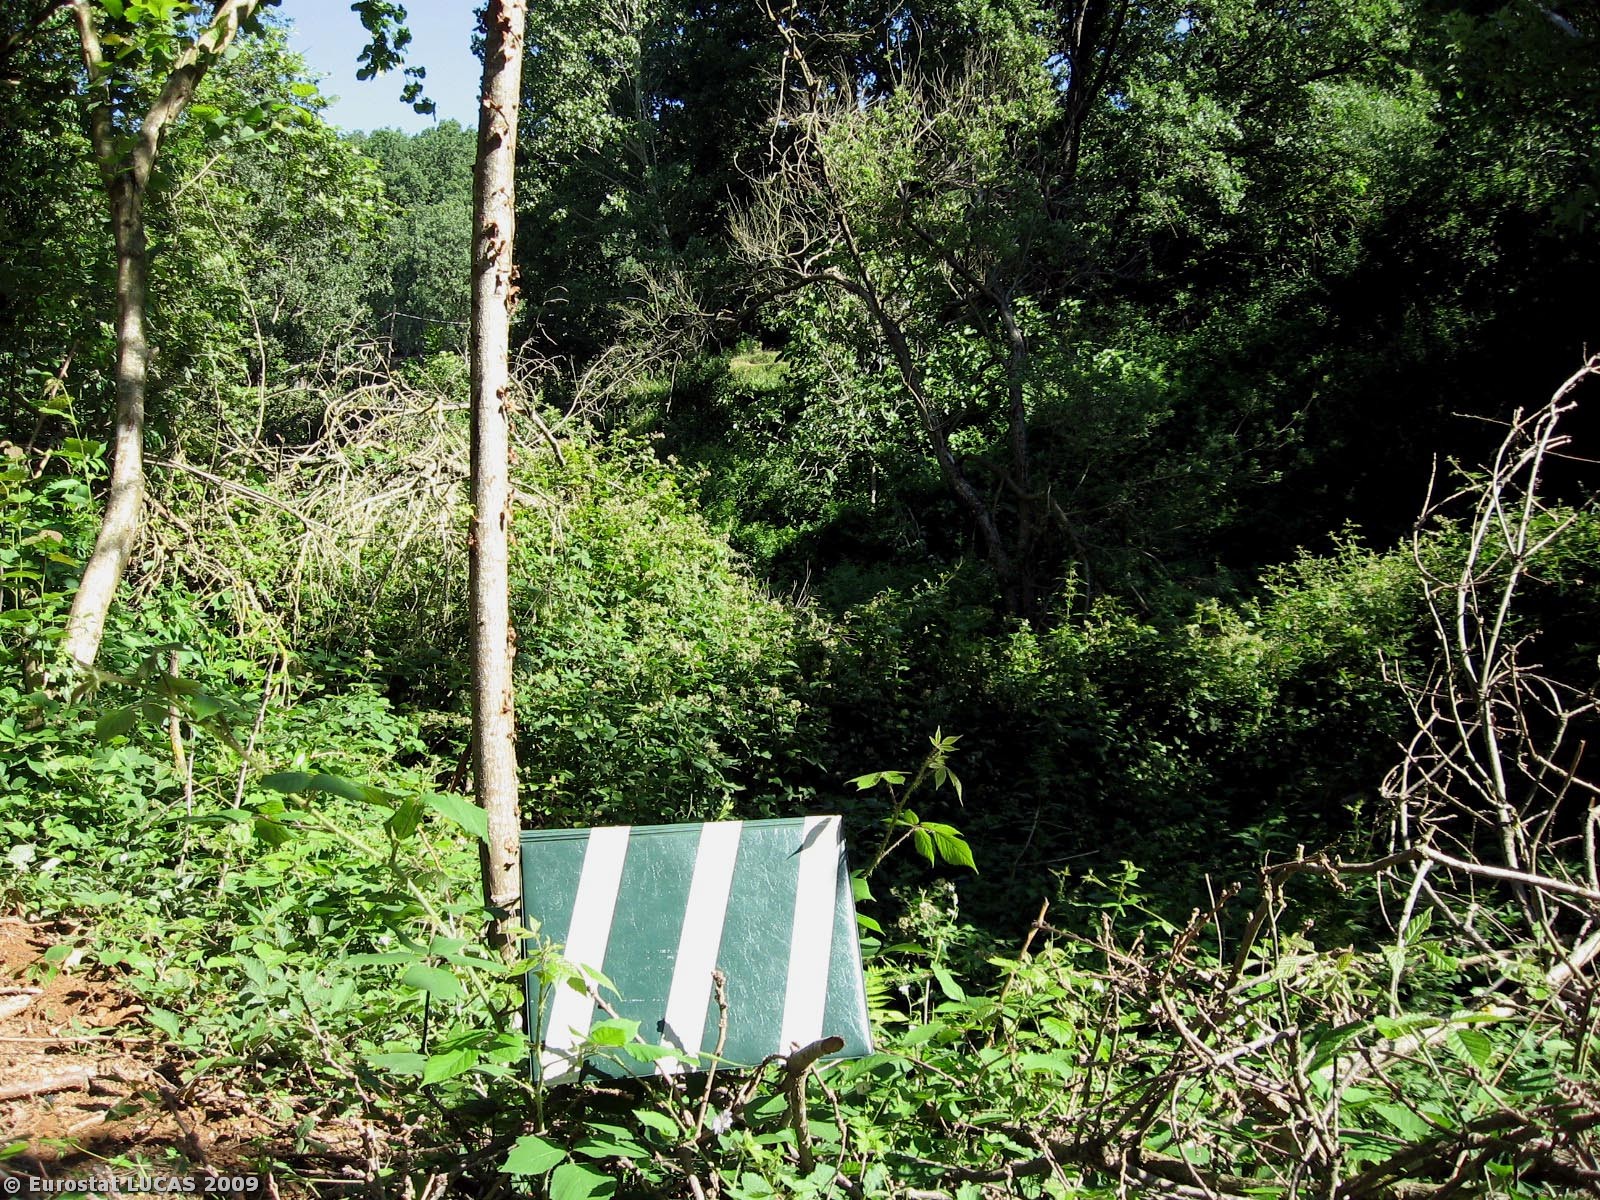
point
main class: Woodland
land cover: Broadleaved woodland
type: thermophilous deciduous forest
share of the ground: 50 - 75 %
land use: Forestry
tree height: > 5 m
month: June
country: IT
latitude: 38.6964
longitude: 16.3924
